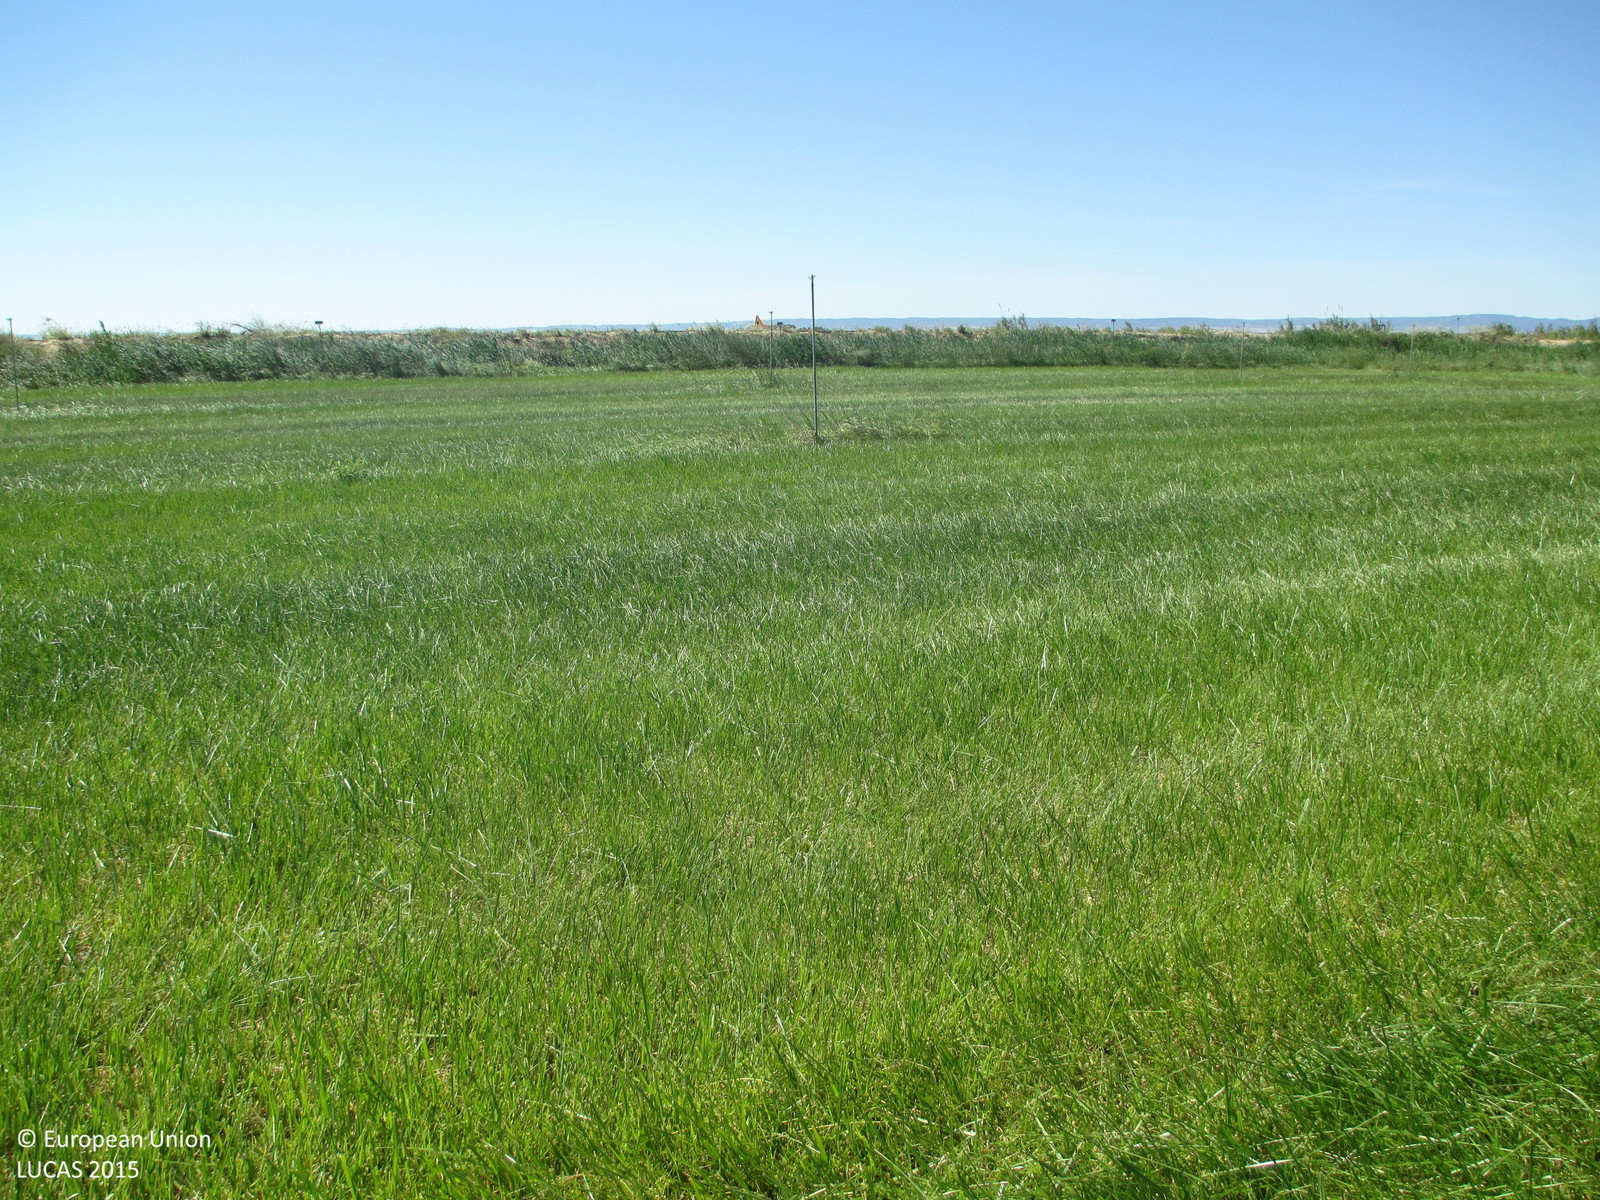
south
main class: Cropland
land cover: Temporary grasslands
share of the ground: > 75 %
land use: Agriculture (excluding fallow land and kitchen gardens)
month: May
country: ES
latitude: 41.8626
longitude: -0.2227
